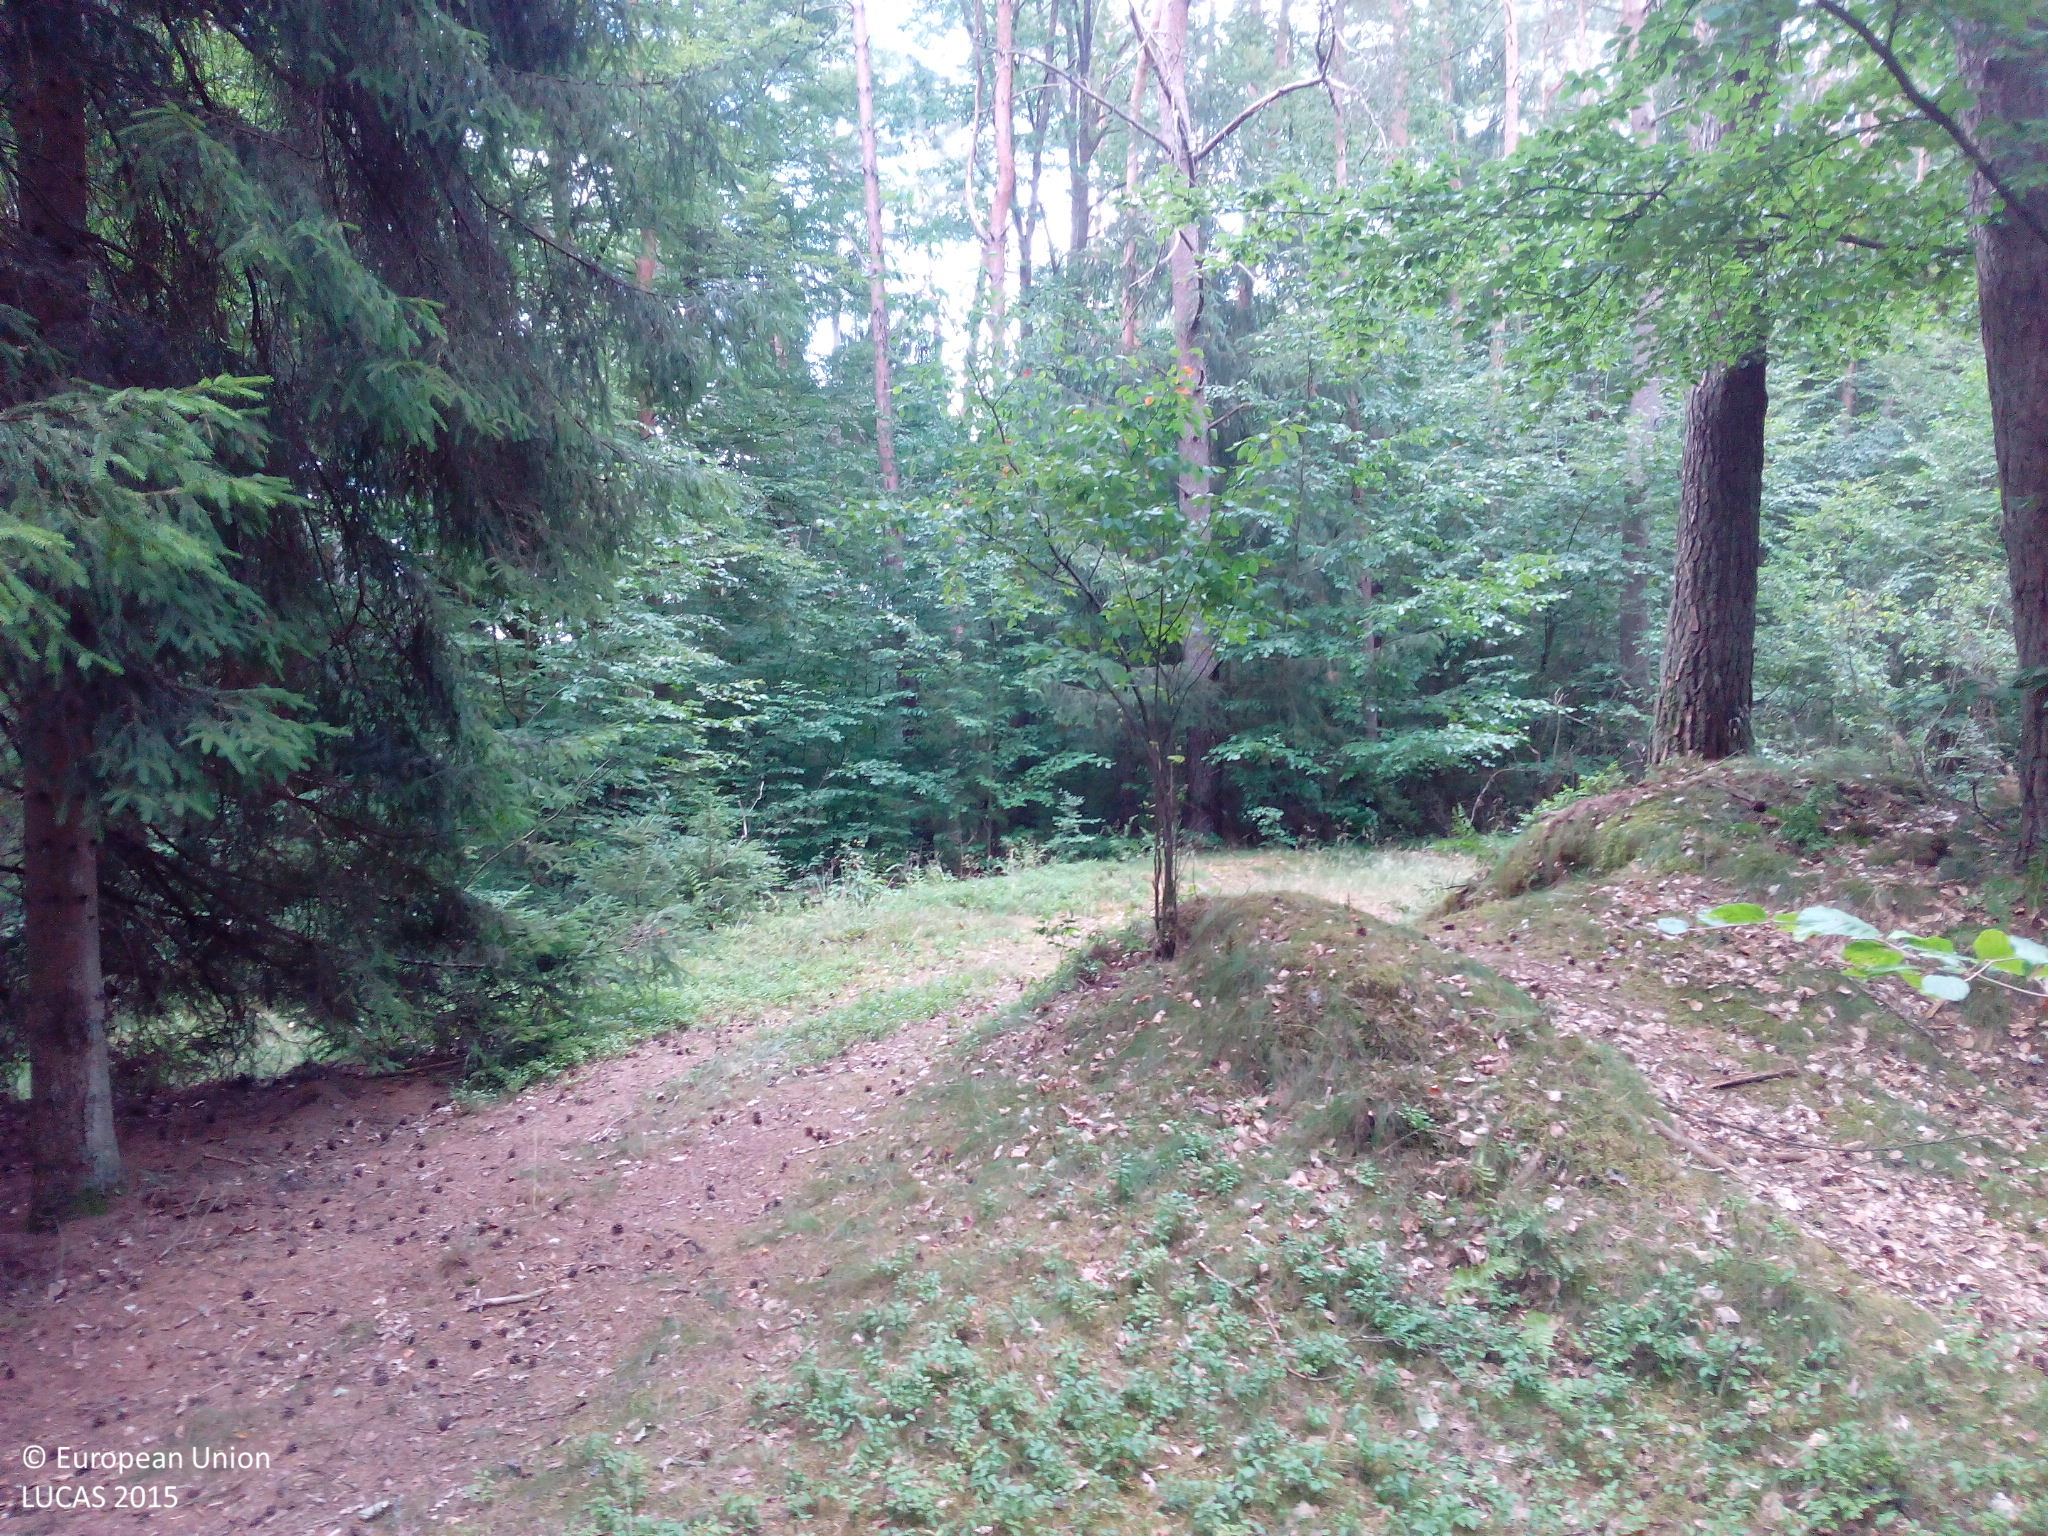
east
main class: Woodland
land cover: Other coniferous woodland
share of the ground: > 75 %
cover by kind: coniferous forest trees 70 %, broadleaved forest trees 15 %, shrubs 5 %, herbaceous plants 5 %, unconsolidated bare surface 5 %
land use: Forestry
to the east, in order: Other coniferous woodland; Artificial constructions in urban areas; Spontaneously vegetated surfaces
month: July
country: DE
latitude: 49.1143
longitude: 7.5482
